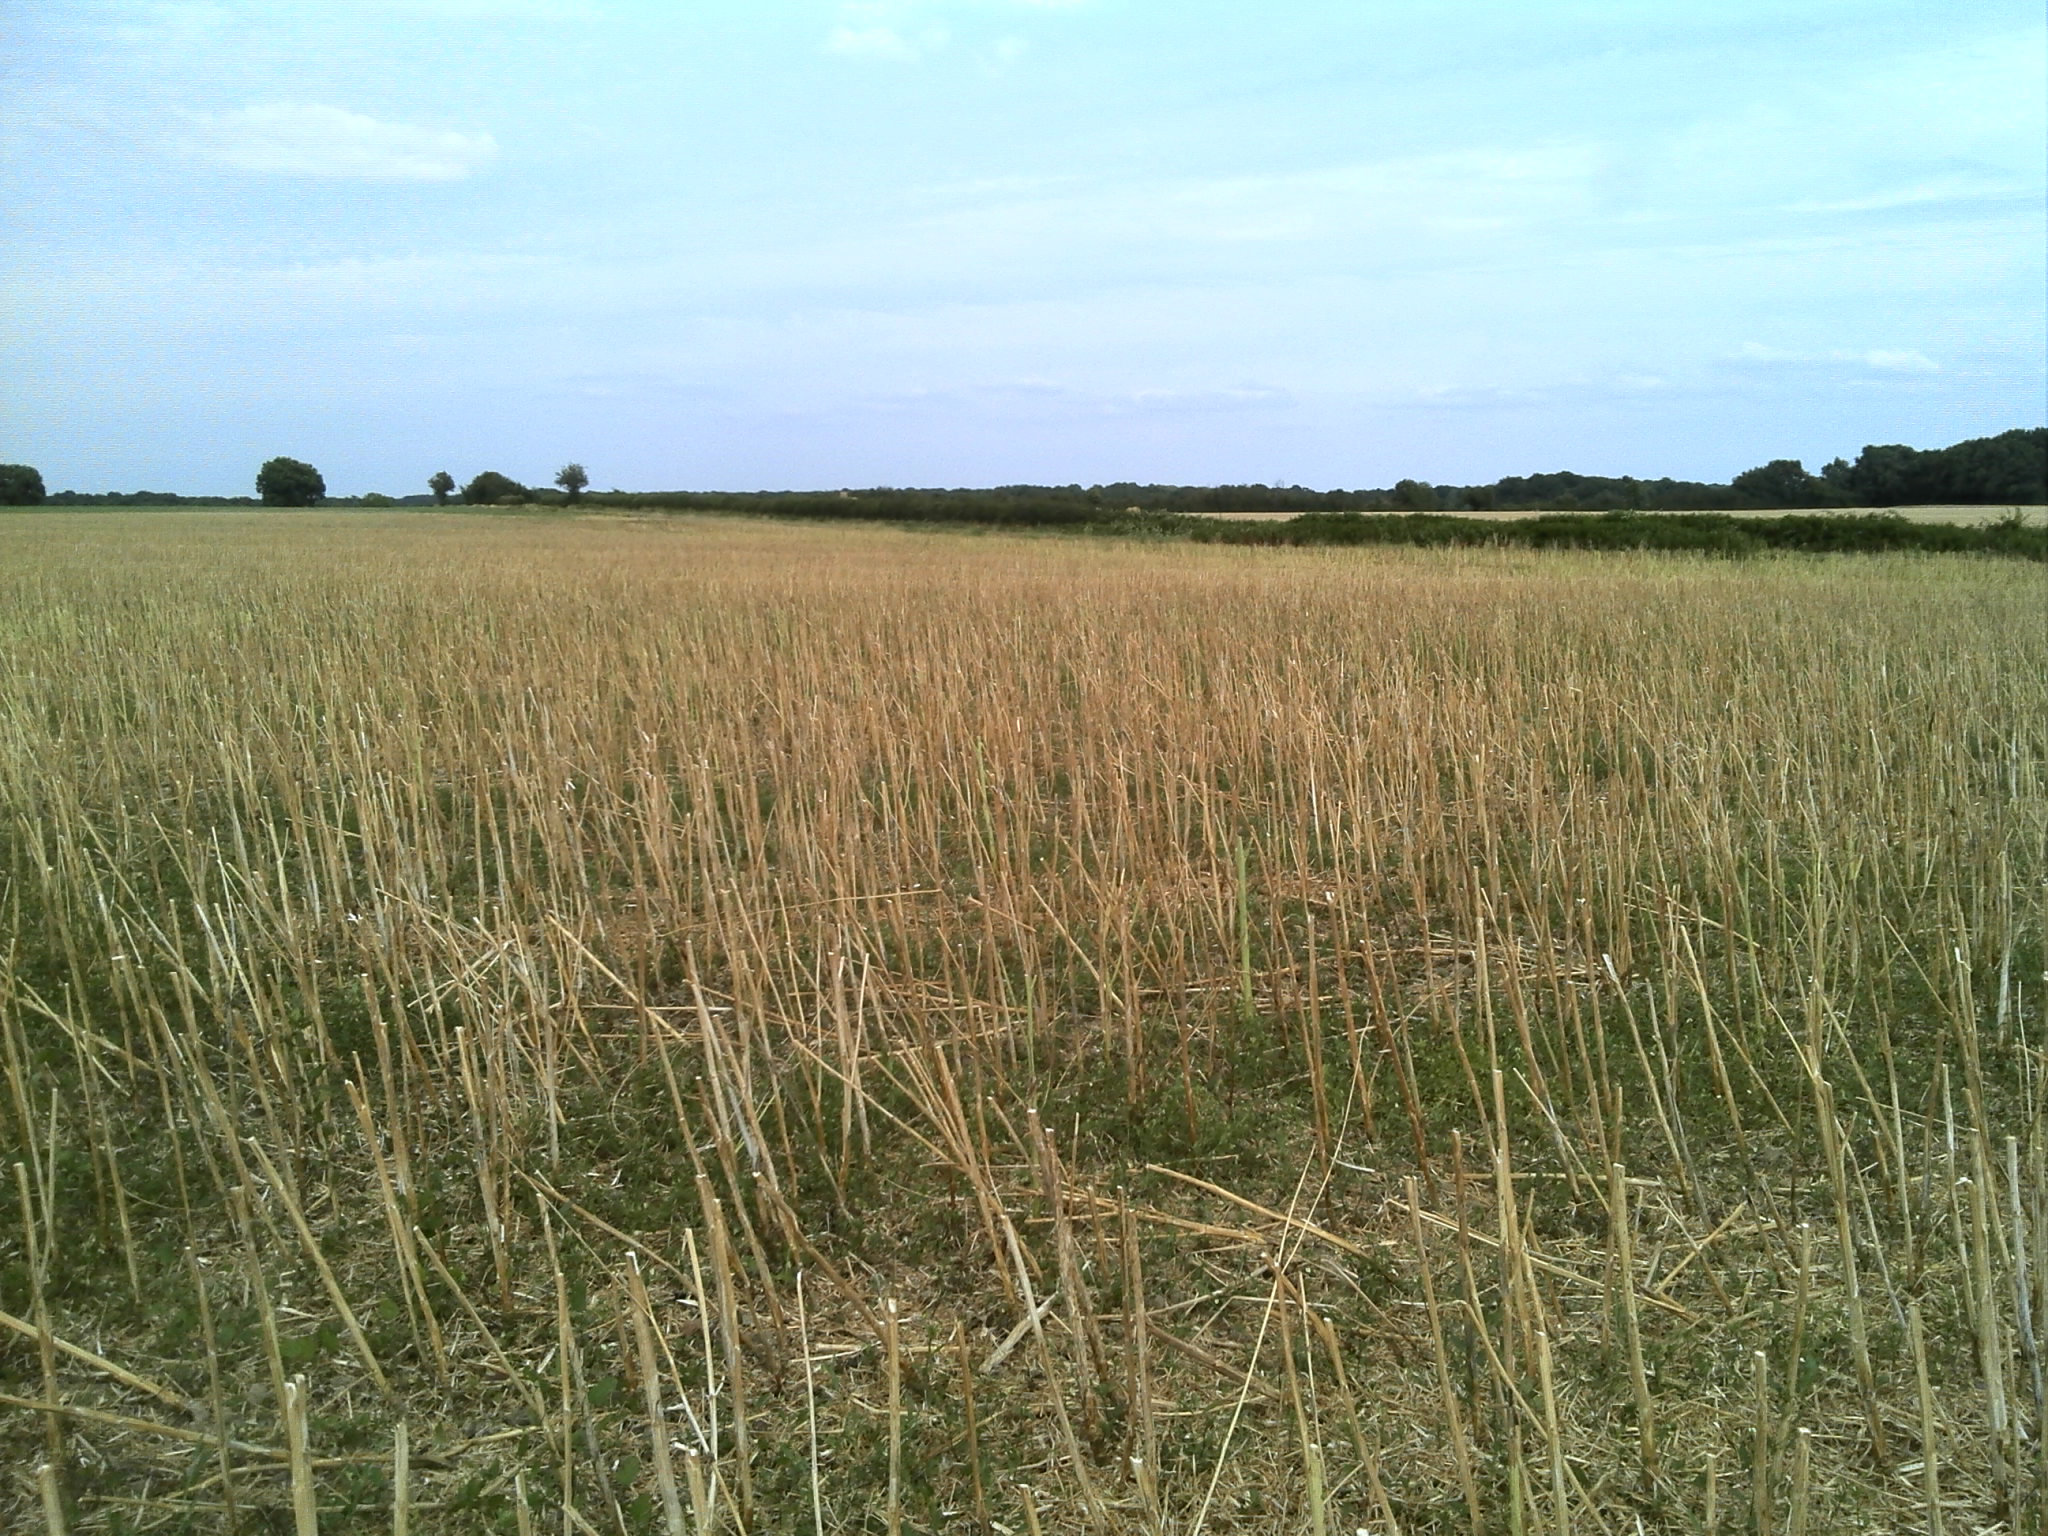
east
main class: Cropland
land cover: Rape and turnip rape
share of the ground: < 10 %
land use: Agriculture (excluding fallow land and kitchen gardens)
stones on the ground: < 10 %
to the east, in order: Rape and turnip rape; Ditches and canals; Grass margins; Paved roads, cycling and walking lanes; Grass margins; Ditches and canals; Managed hedges; Common wheat
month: July
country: FR
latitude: 46.6984
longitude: 1.4751
